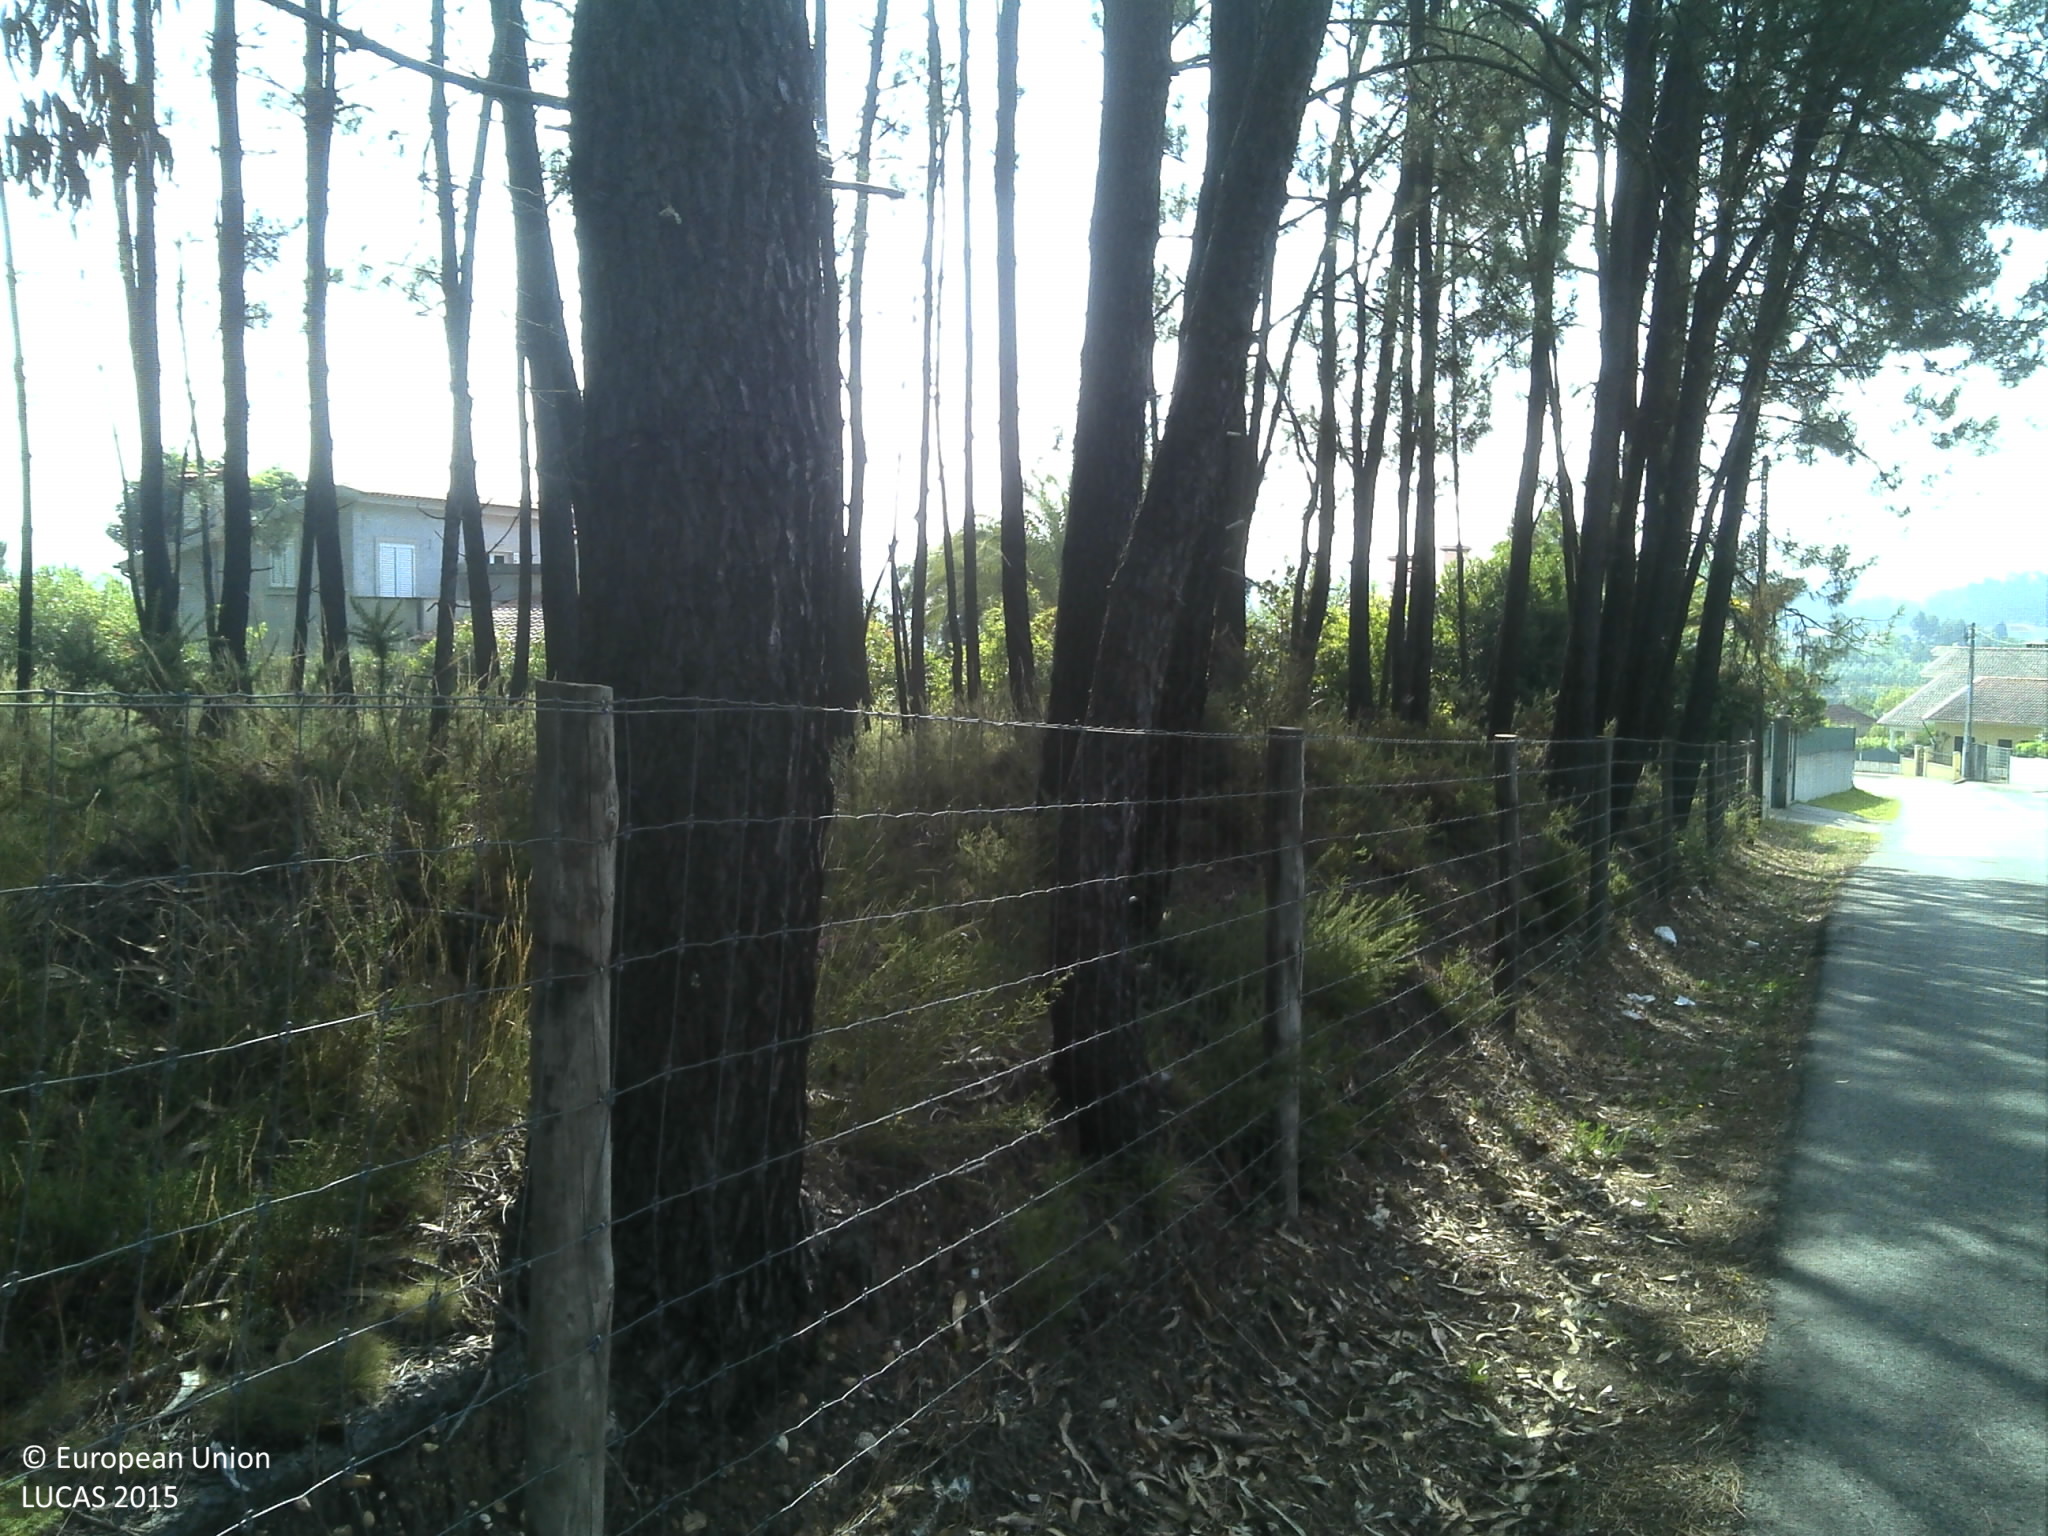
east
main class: Woodland
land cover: Pine dominated coniferous woodland
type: coniferous forest of the mediterranean region
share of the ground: 50 - 75 %
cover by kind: coniferous forest trees 60 %, shrubs 20 %, unconsolidated bare surface 20 %
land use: Forestry
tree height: > 5 m
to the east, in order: Pine dominated coniferous woodland; Shrubland with sparse tree cover; Artificial constructions in urban areas; Other fruit trees and berries; Fences; Other root crops; Vineyards; Dry stone walls; Grassland without tree/shrub cover; Vineyards; Dry stone walls; Other bare soil; Spontaneously vegetated surfaces; Other root crops; Artificial constructions in urban areas
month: July
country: PT
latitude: 40.6096
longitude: -8.4460
